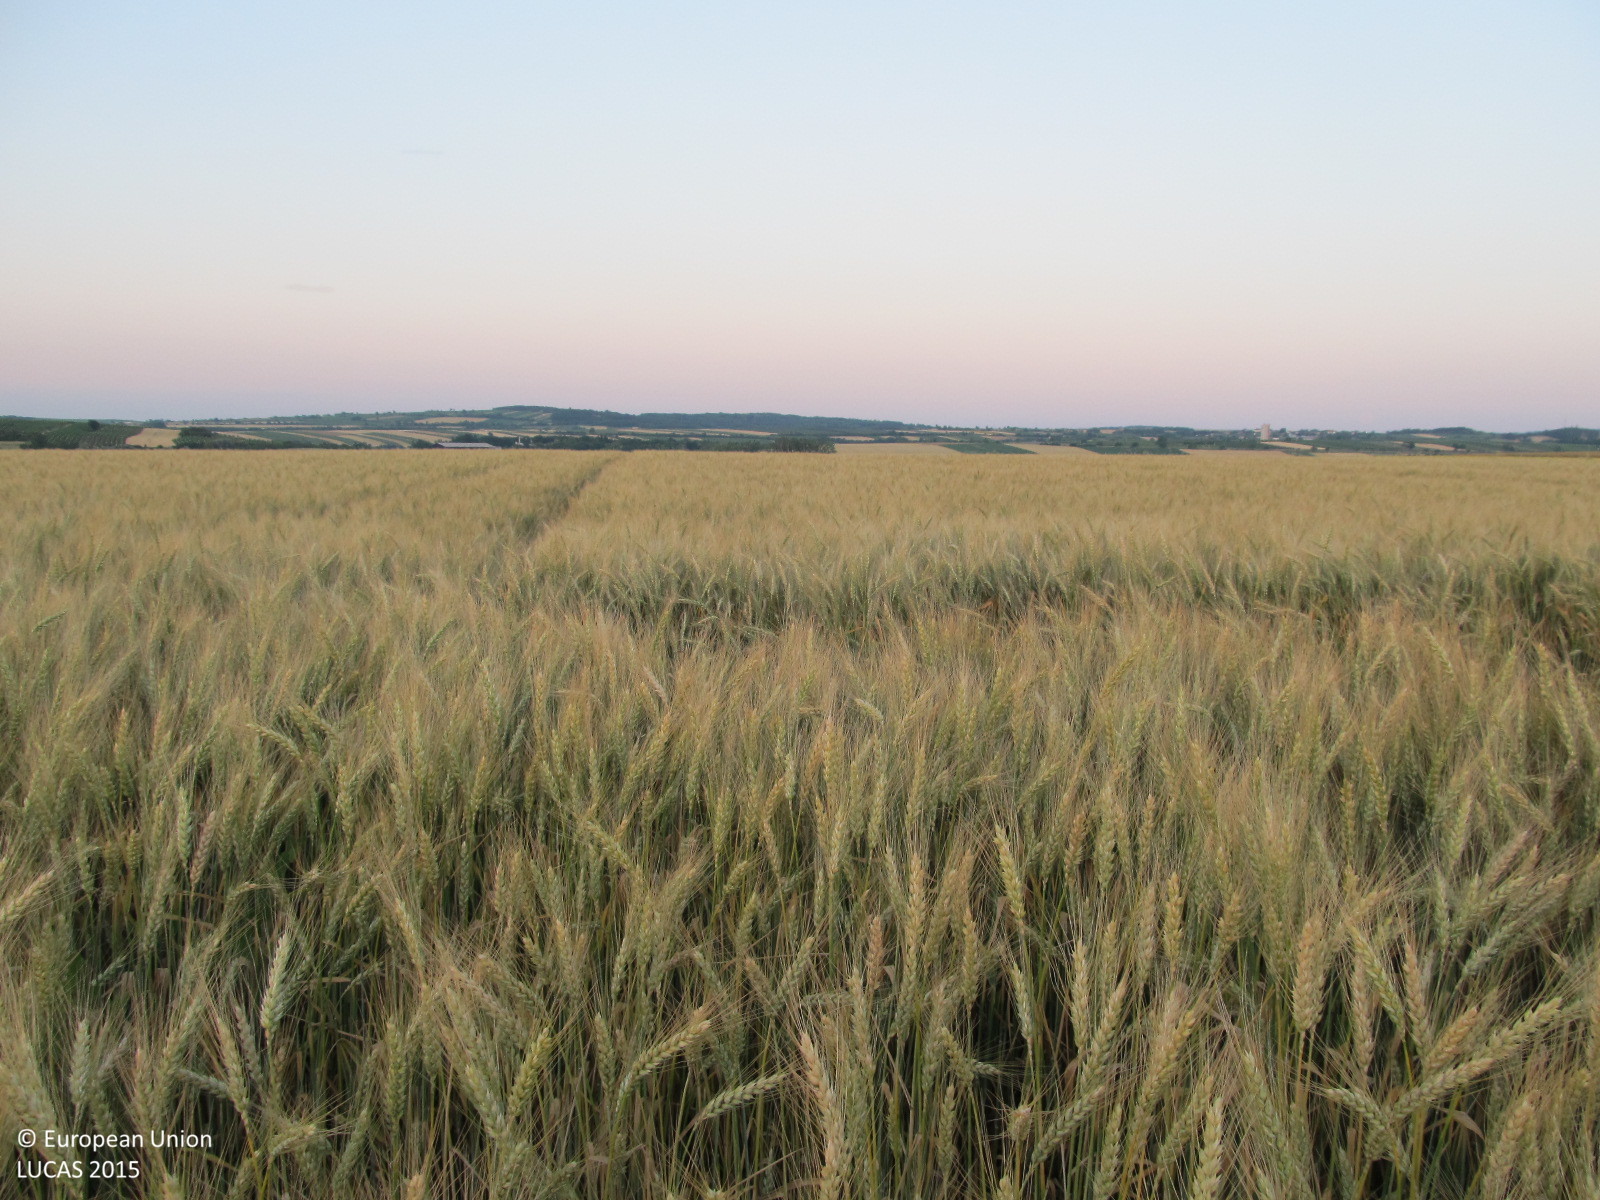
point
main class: Cropland
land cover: Common wheat
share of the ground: > 75 %
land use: Agriculture (excluding fallow land and kitchen gardens)
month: July
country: AT
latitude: 48.7156
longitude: 15.8893
